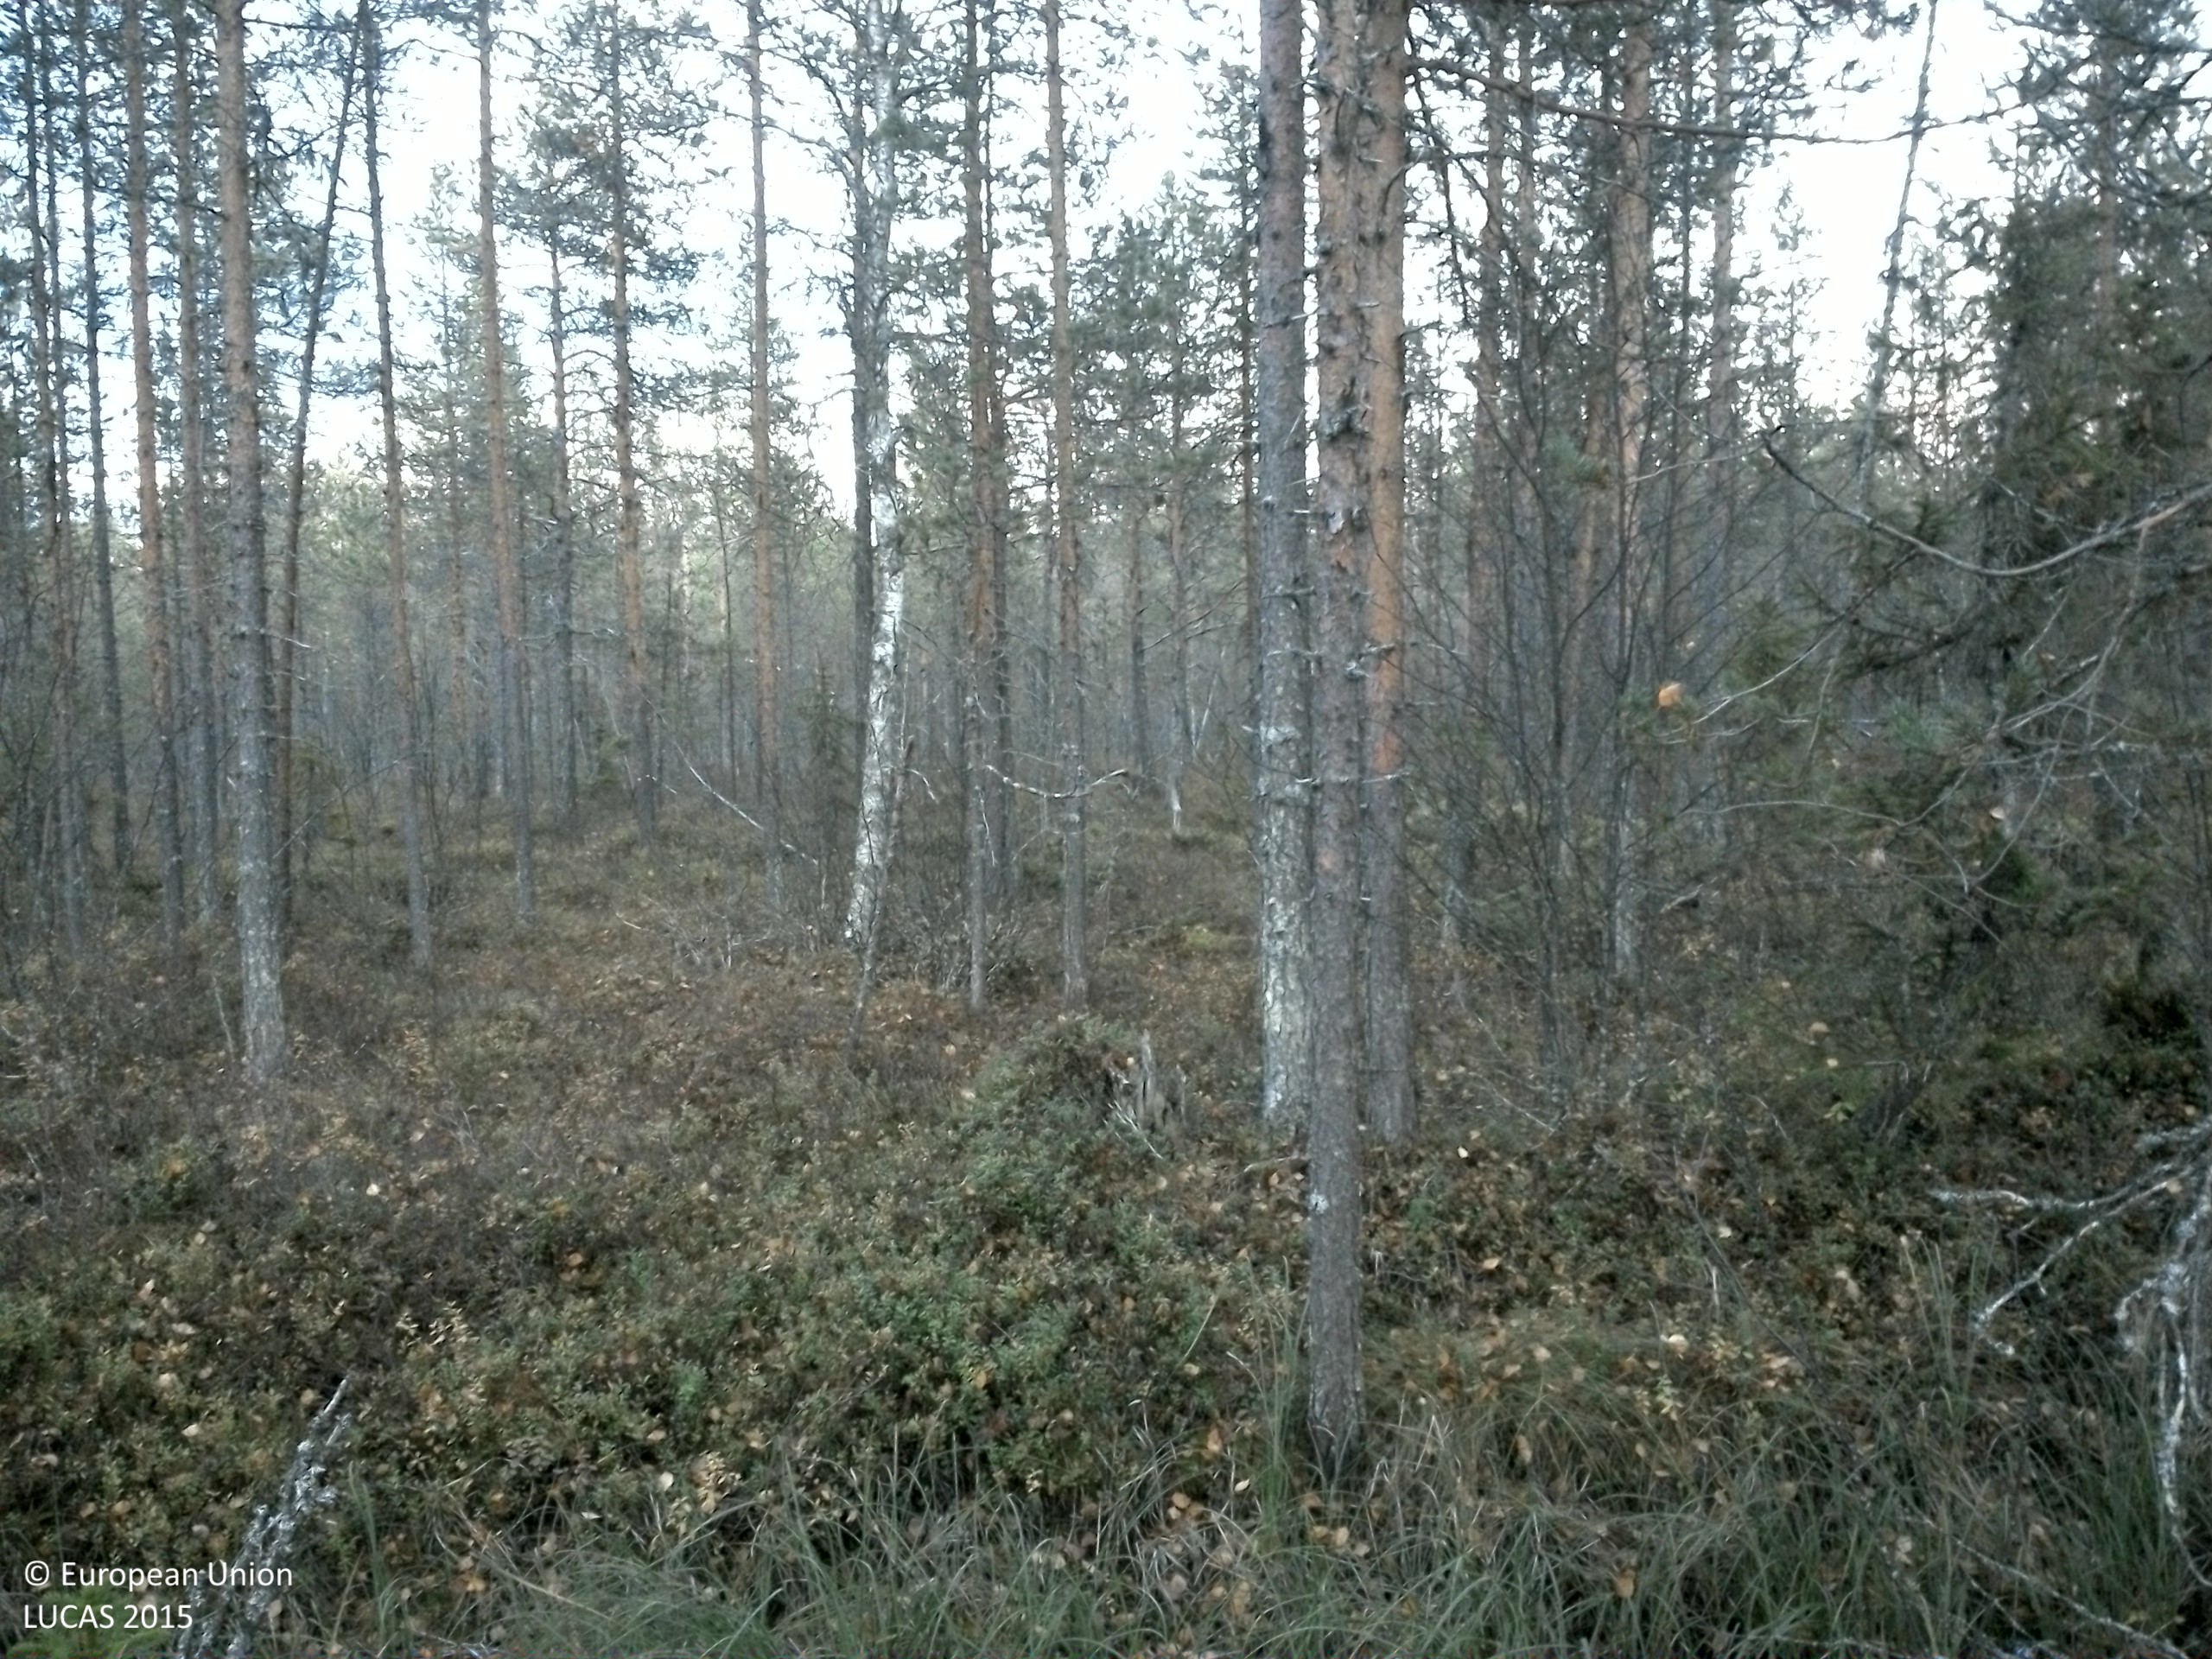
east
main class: Woodland
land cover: Pine dominated coniferous woodland
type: boreal forest
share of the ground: 25 - 50 %
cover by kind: shrubs 45 %, coniferous forest trees 35 %, broadleaved forest trees 10 %, lichens and mosses 10 %
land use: Forestry
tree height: > 5 m
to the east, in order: Pine dominated coniferous woodland; Ditches and canals; Pine dominated coniferous woodland; Ditches and canals; Pine dominated mixed woodland; Spruce dominated mixed woodland; Ditches and canals; Spruce dominated mixed woodland; Pine dominated mixed woodland; Pine dominated coniferous woodland
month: September
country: SE
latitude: 64.2531
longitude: 16.3451
